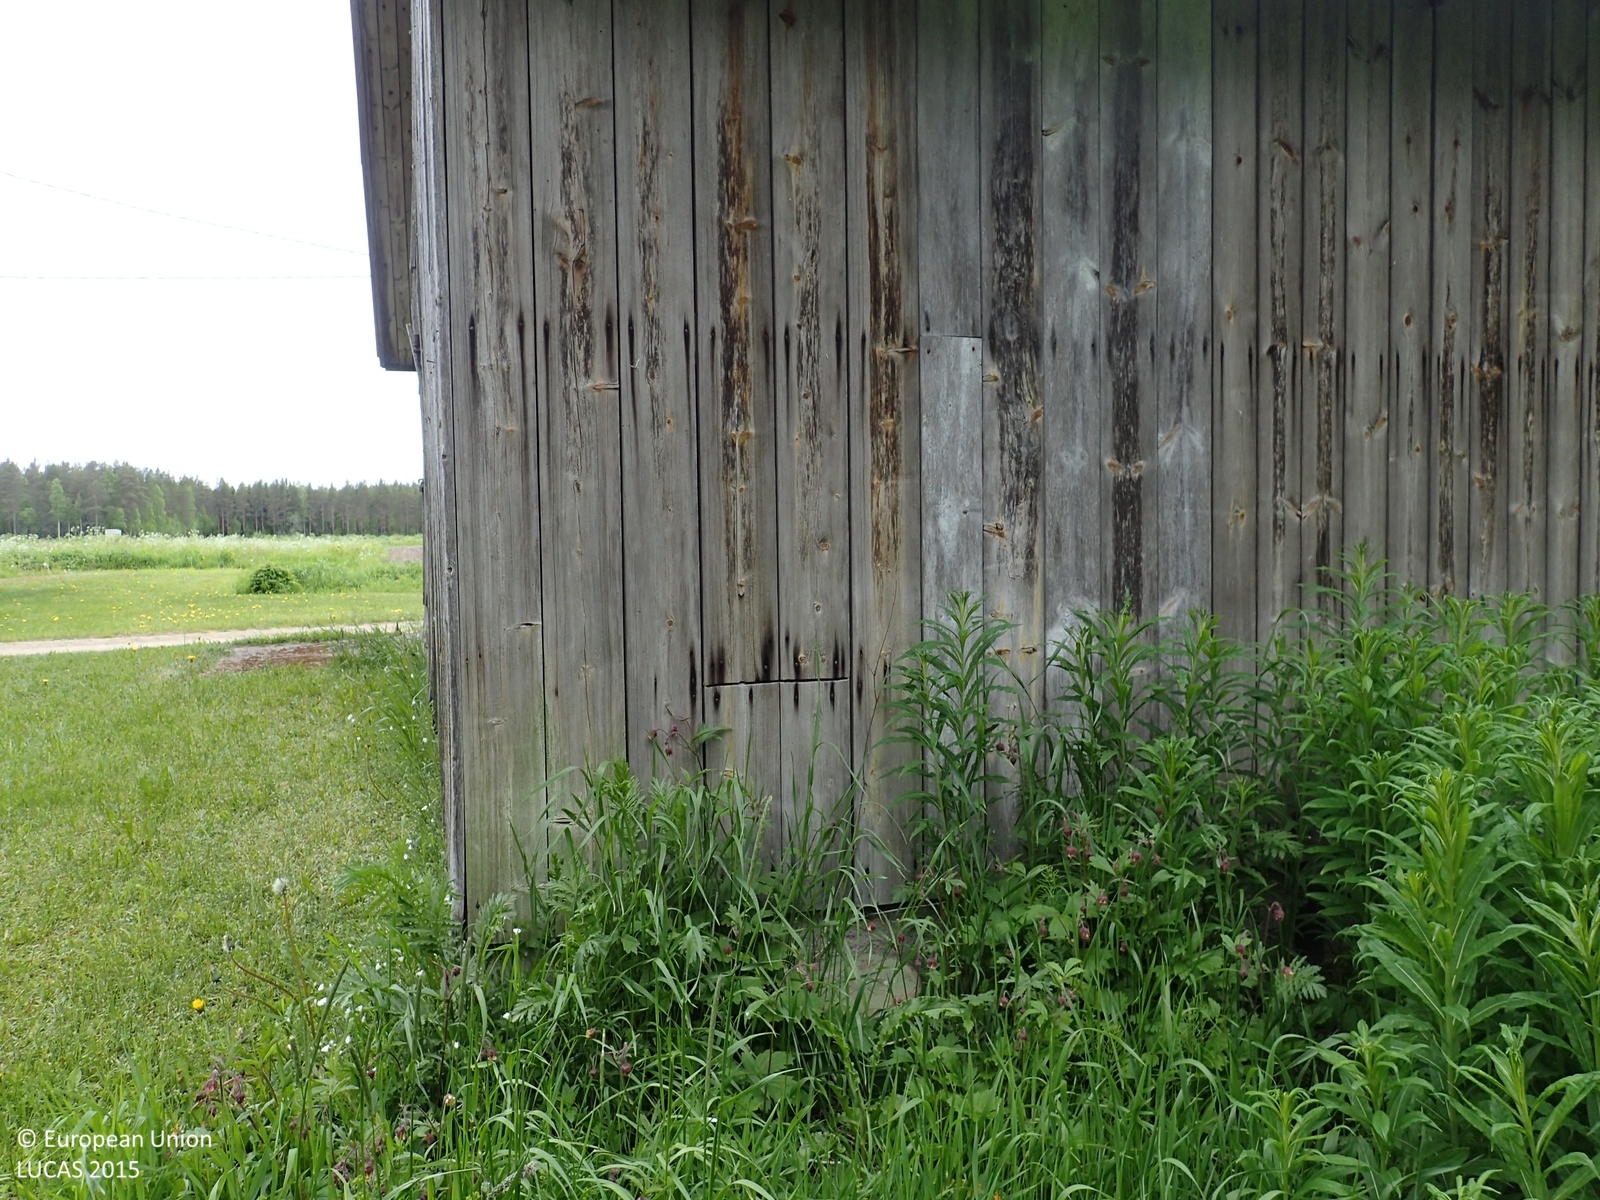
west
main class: Grassland
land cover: Grassland with sparse tree/shrub cover
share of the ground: > 75 %
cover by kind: herbaceous plants 95 %, broadleaved forest trees 5 %
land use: Residential
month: June
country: FI
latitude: 62.4212
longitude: 22.4666
